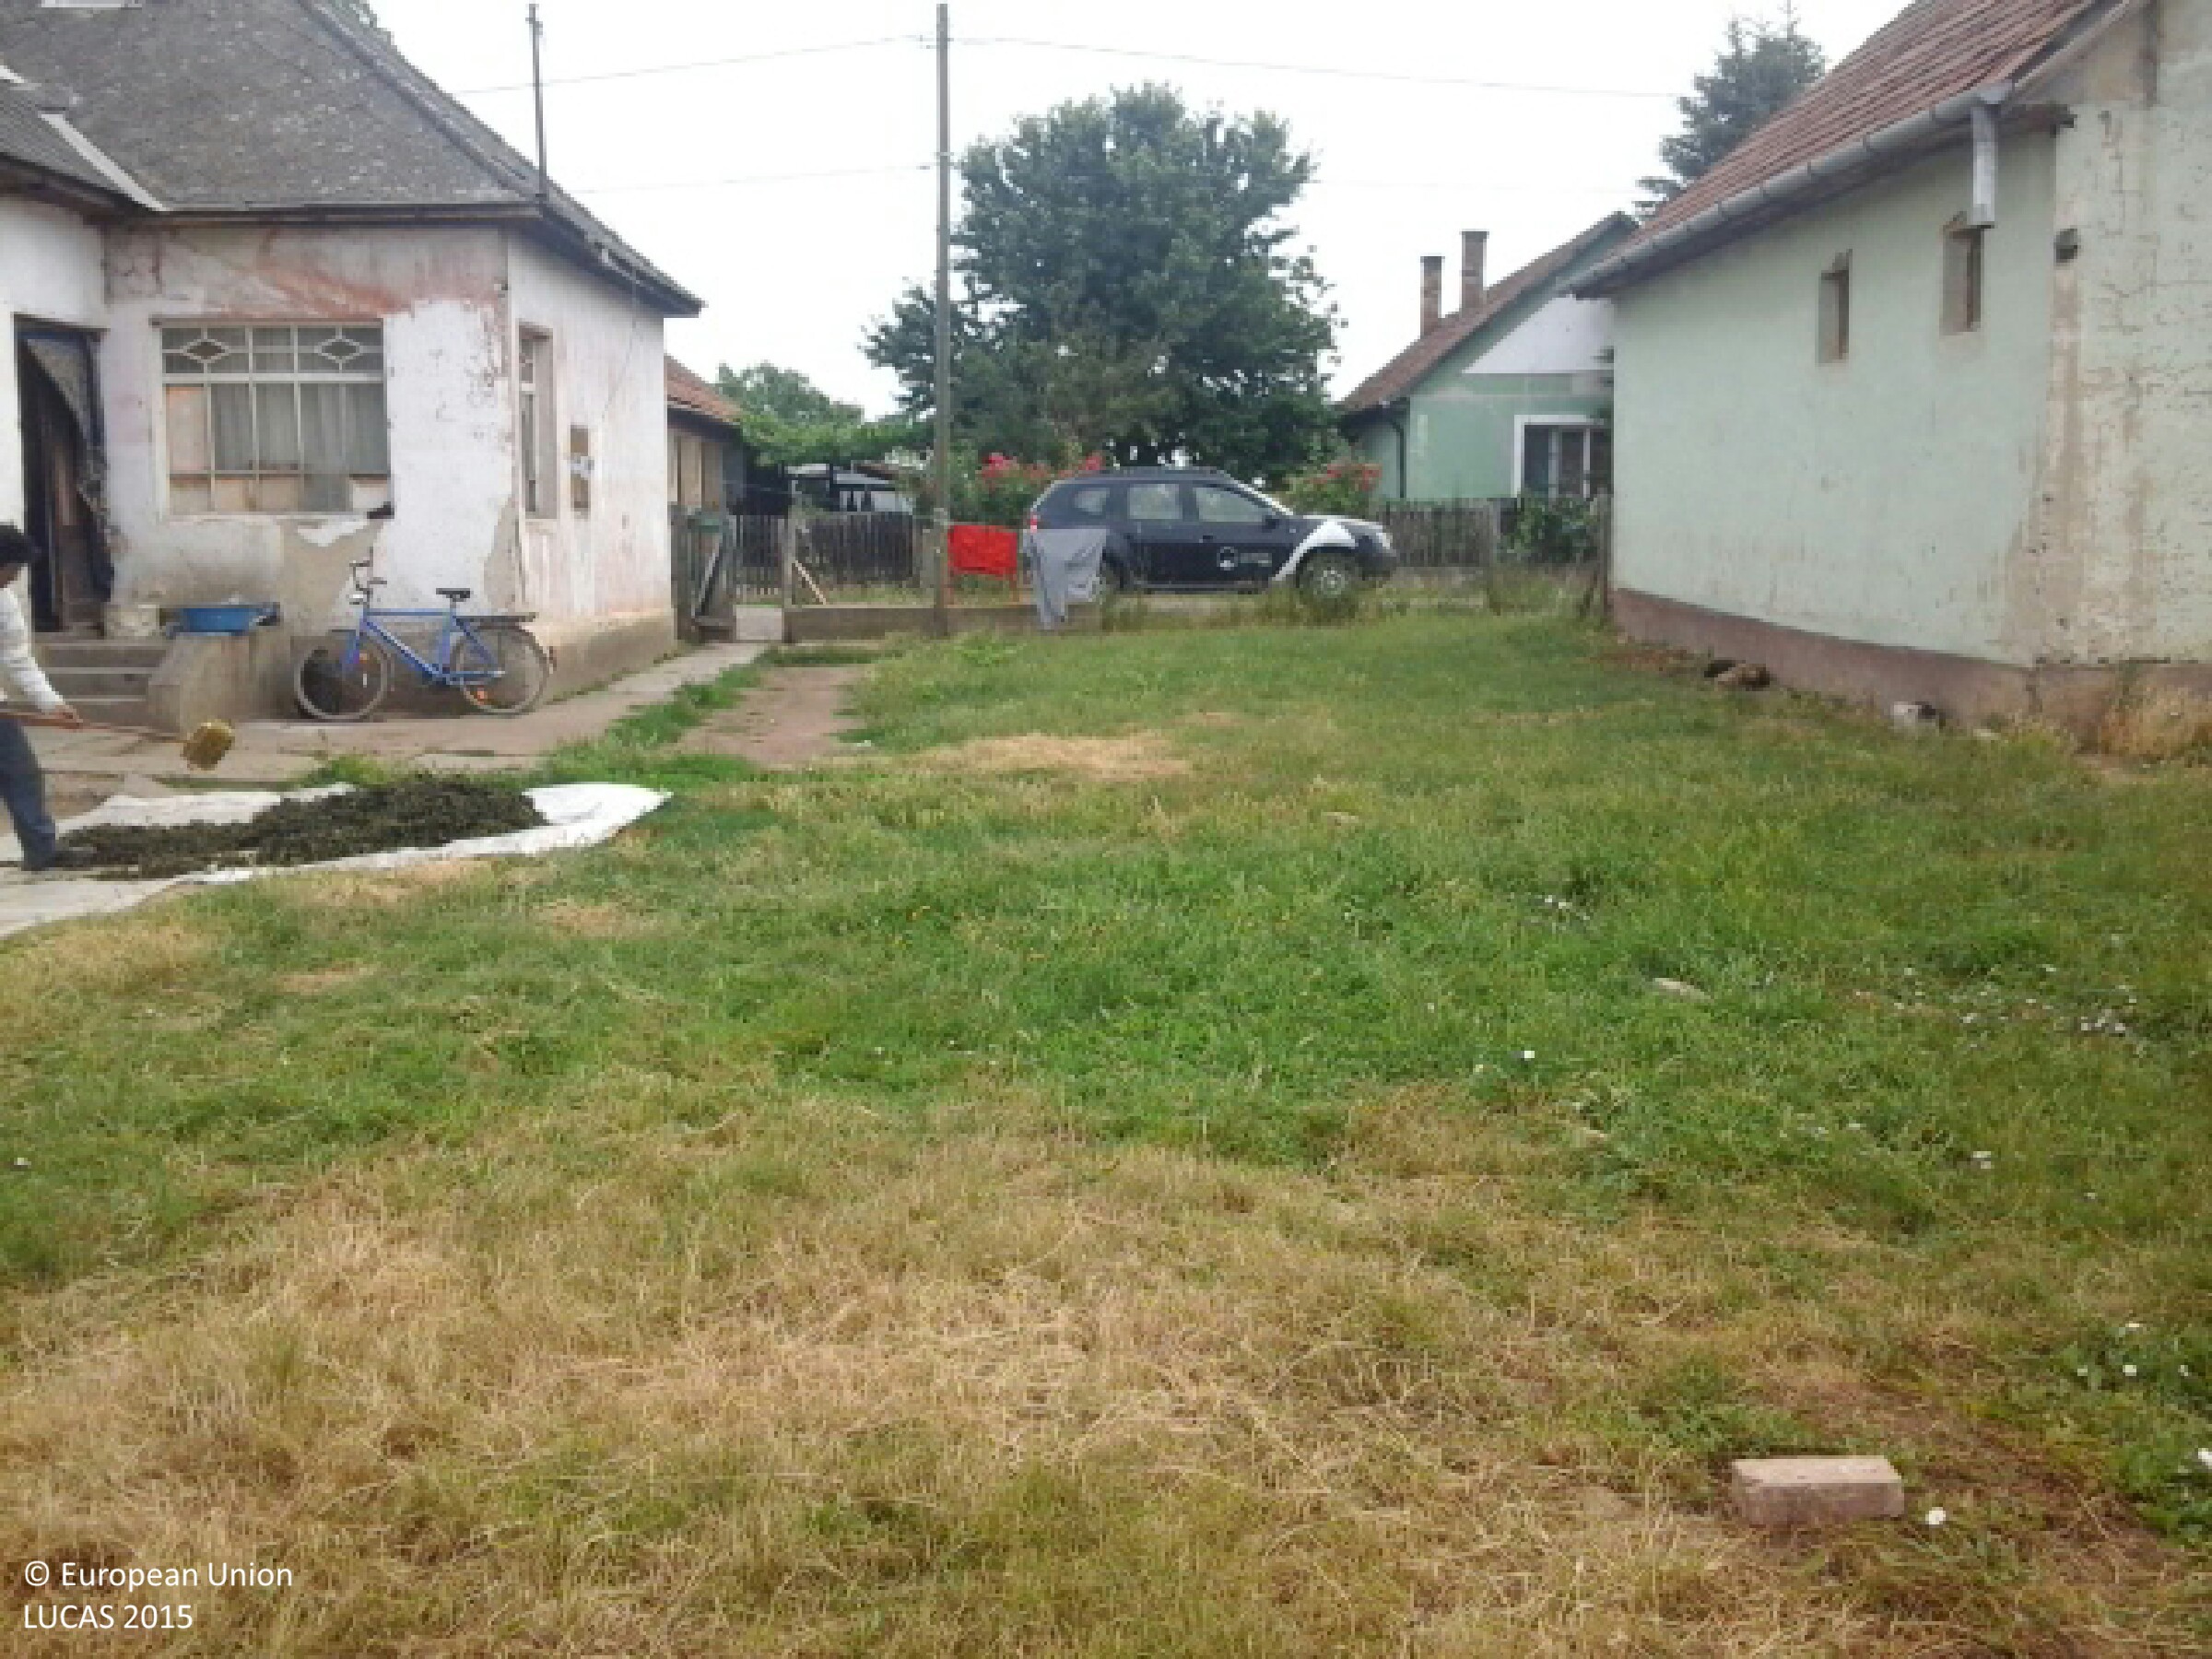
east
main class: Grassland
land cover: Grassland without tree/shrub cover
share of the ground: > 75 %
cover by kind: herbaceous plants 100 %
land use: Residential
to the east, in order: Grassland without tree/shrub cover; Artificial constructions in urban areas; Abandoned hedges; Maize; Common wheat
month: June
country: HU
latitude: 48.0240
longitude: 21.4555
